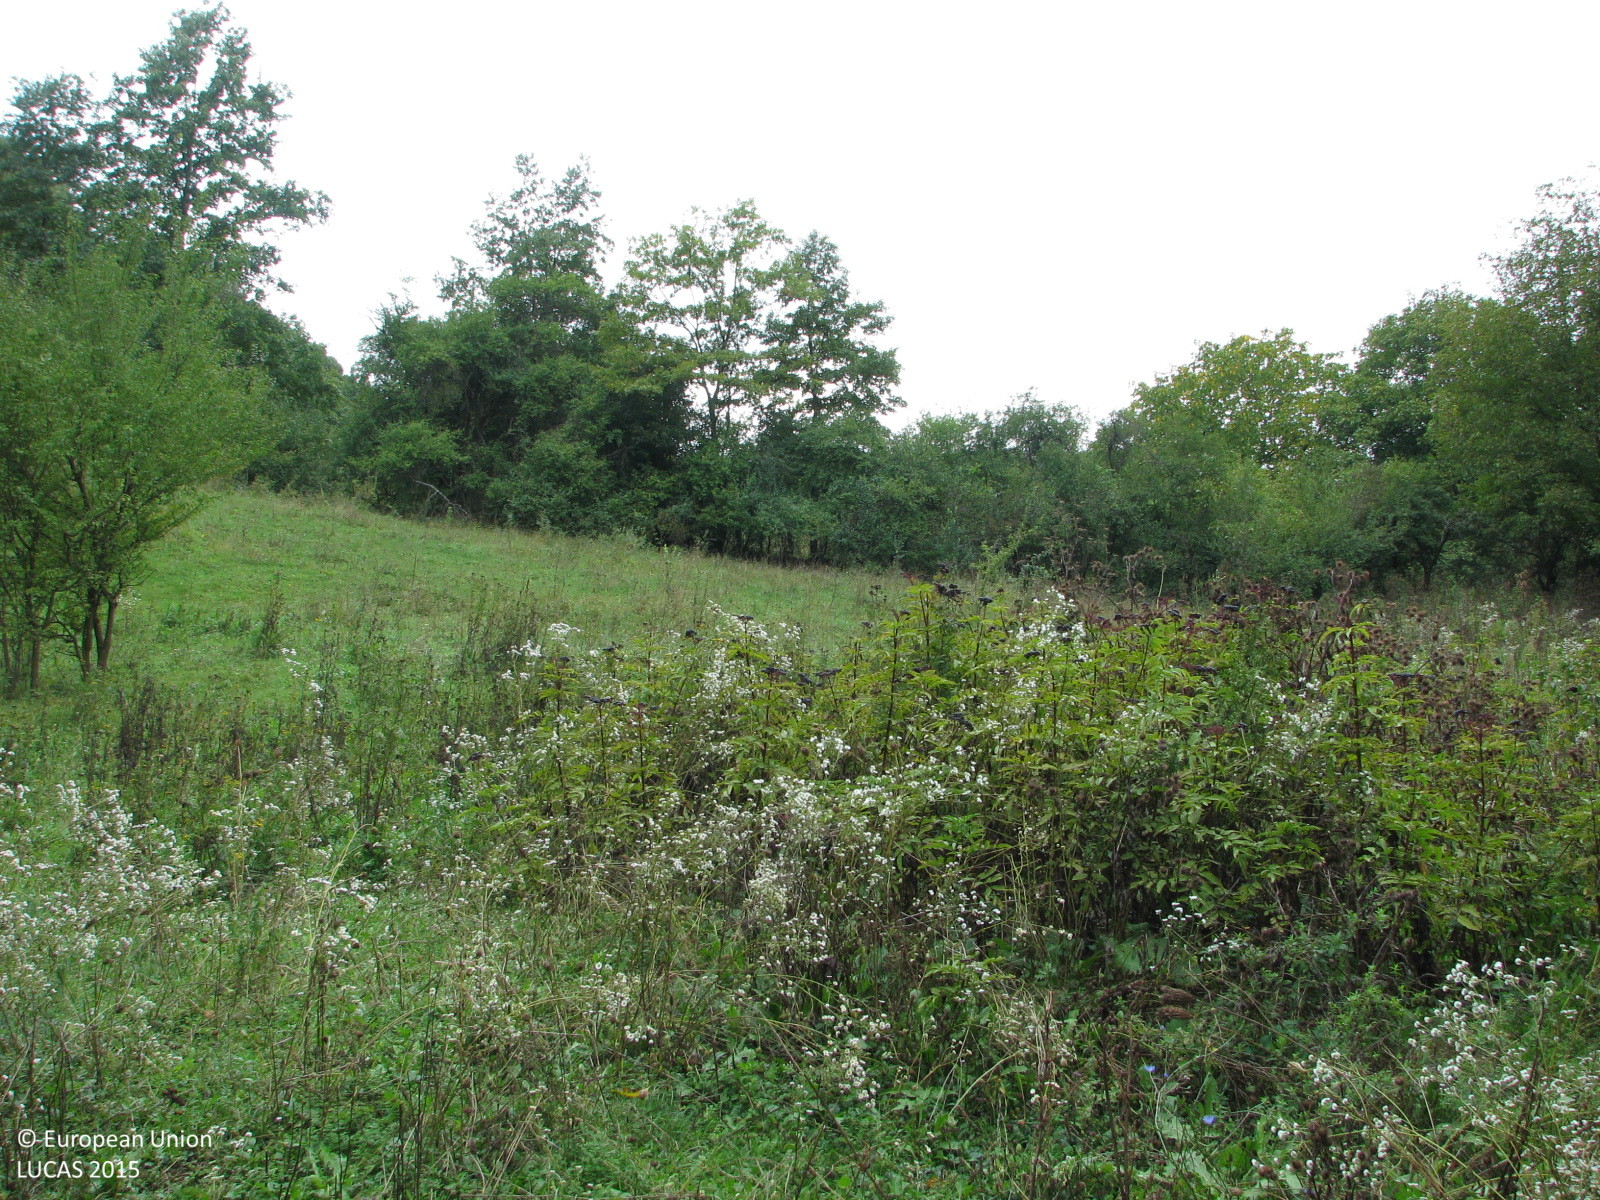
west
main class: Grassland
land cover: Grassland without tree/shrub cover
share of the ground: > 75 %
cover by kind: herbaceous plants 100 %
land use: Agriculture (excluding fallow land and kitchen gardens)
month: September
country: BG
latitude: 42.7680
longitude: 26.4585
